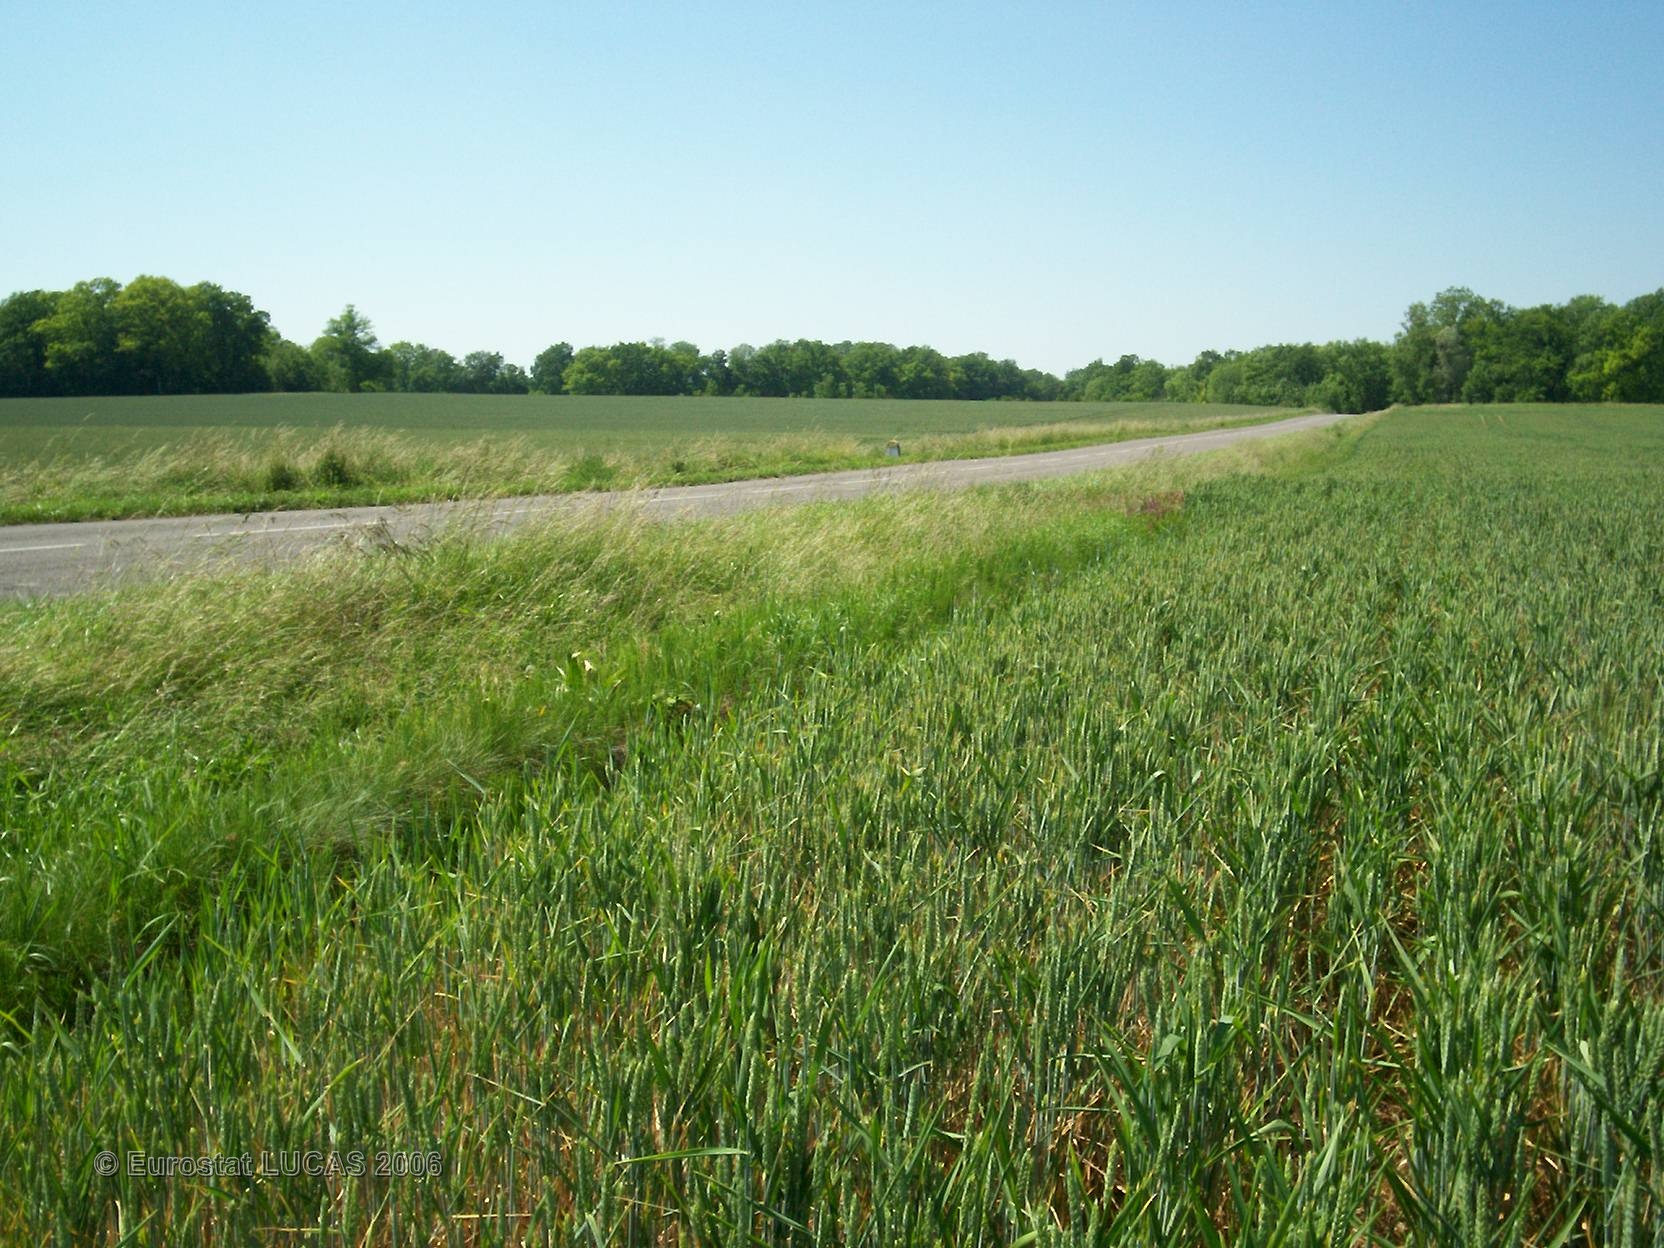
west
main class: Cropland
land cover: Common wheat
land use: Agriculture (excluding fallow land and kitchen gardens)
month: June
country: FR
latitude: 48.8775
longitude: 4.8298
